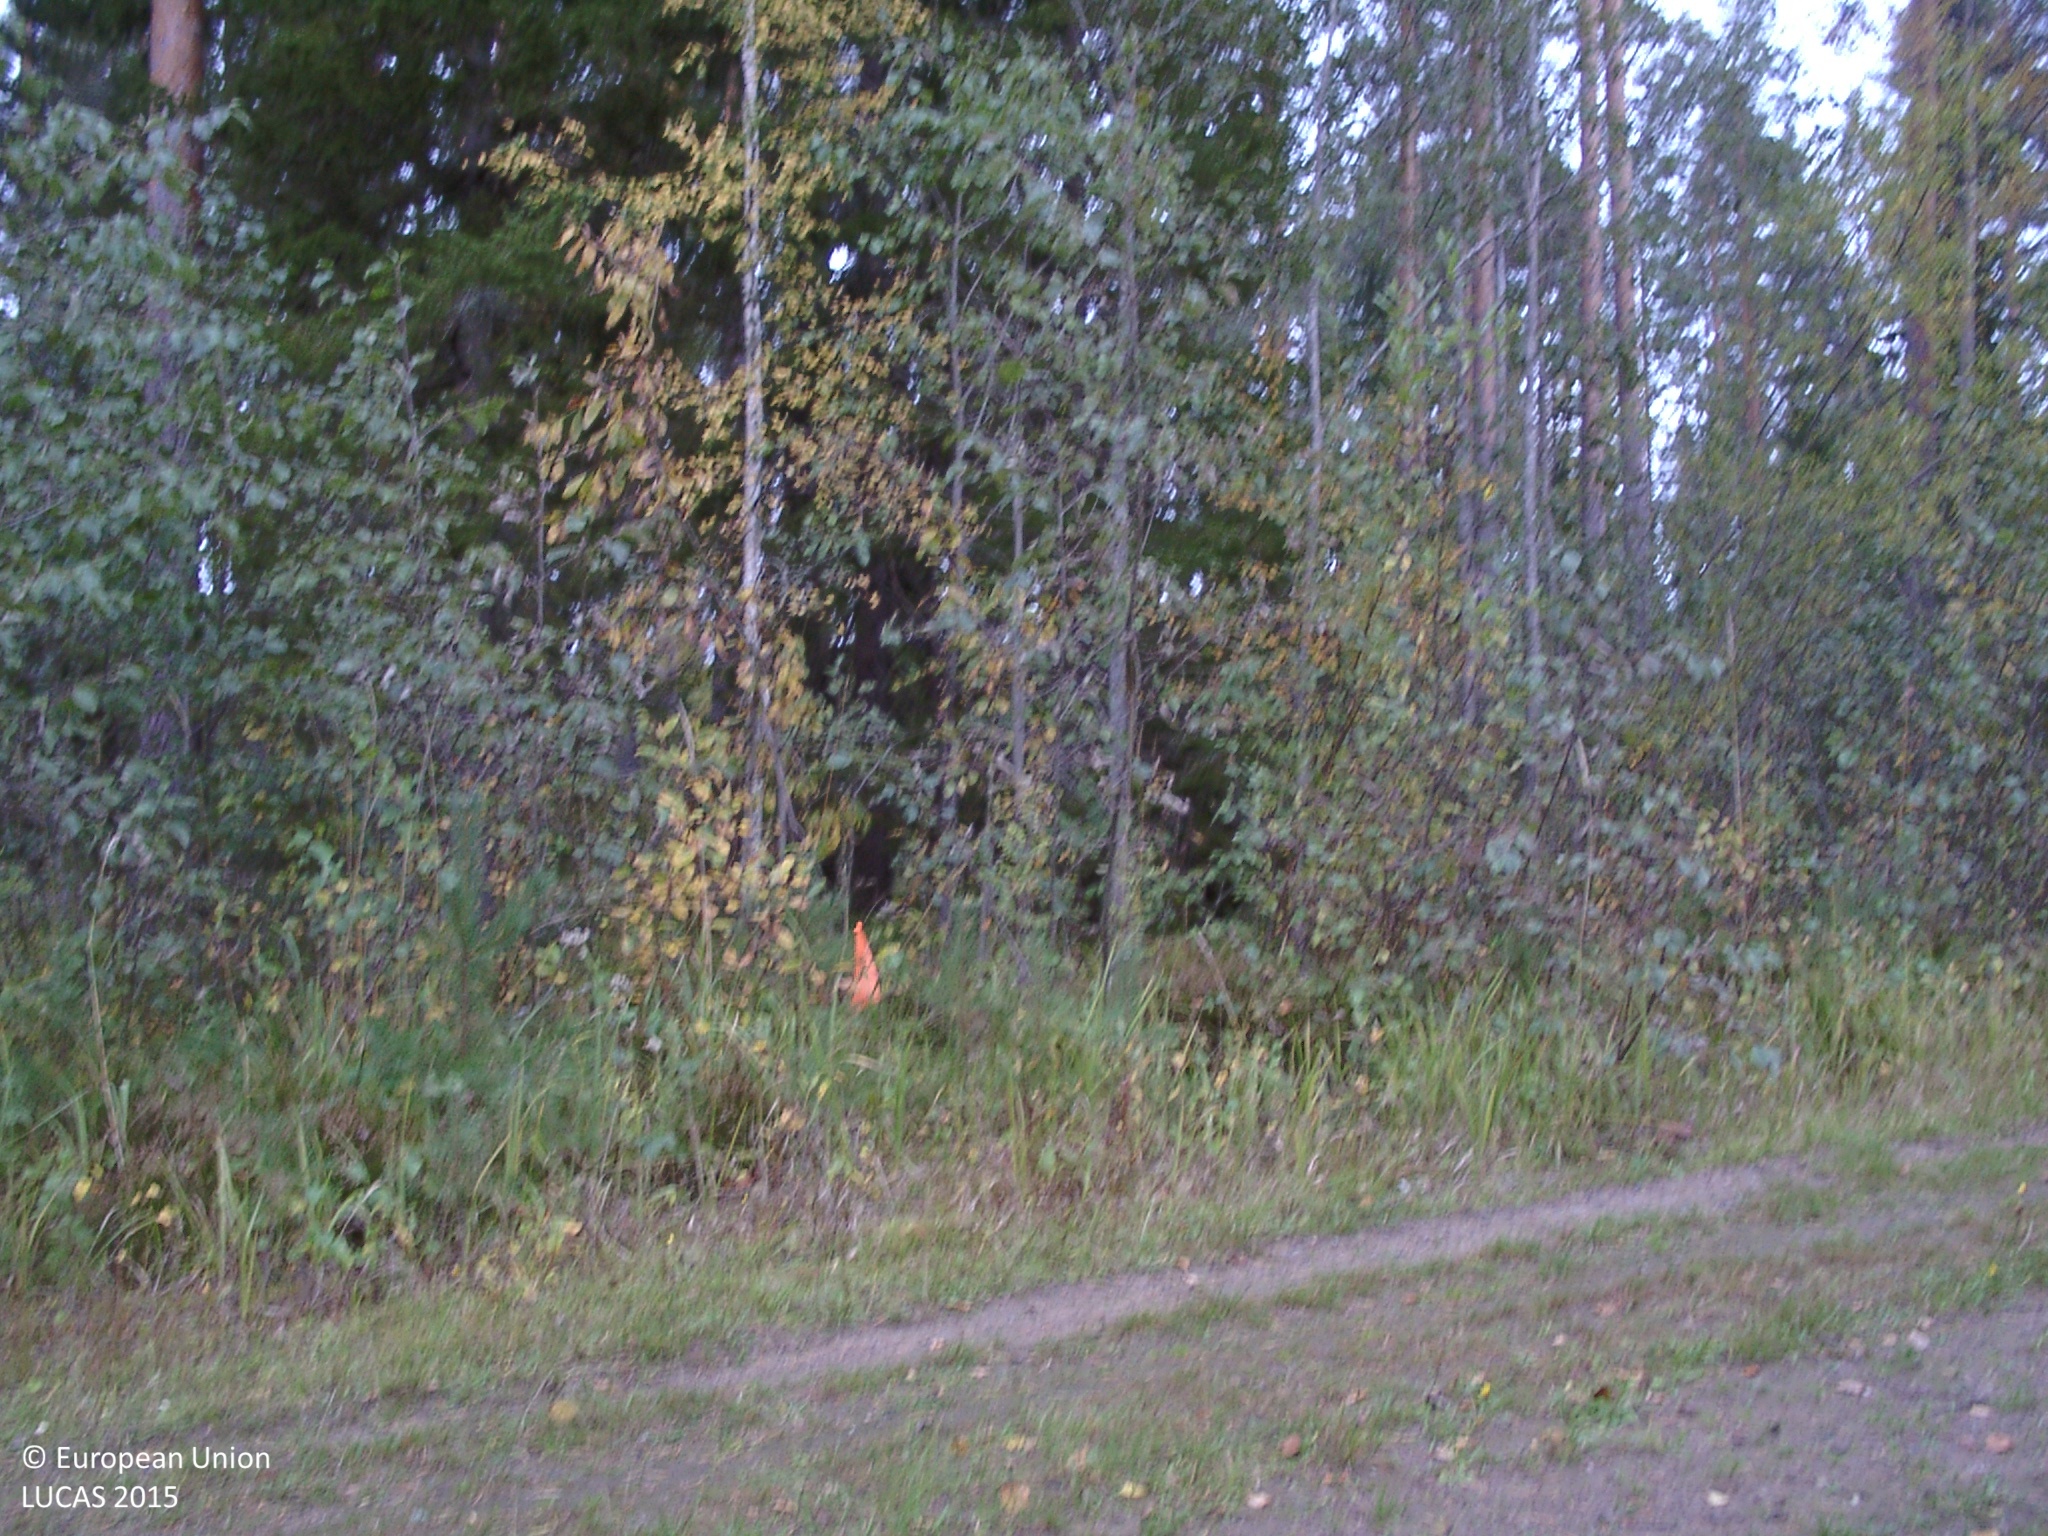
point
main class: Woodland
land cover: Broadleaved woodland
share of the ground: 25 - 50 %
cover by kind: herbaceous plants 40 %, broadleaved forest trees 30 %, shrubs 15 %, lichens and mosses 10 %, coniferous forest trees 5 %
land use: Forestry
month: September
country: FI
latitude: 62.8069
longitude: 25.9484
